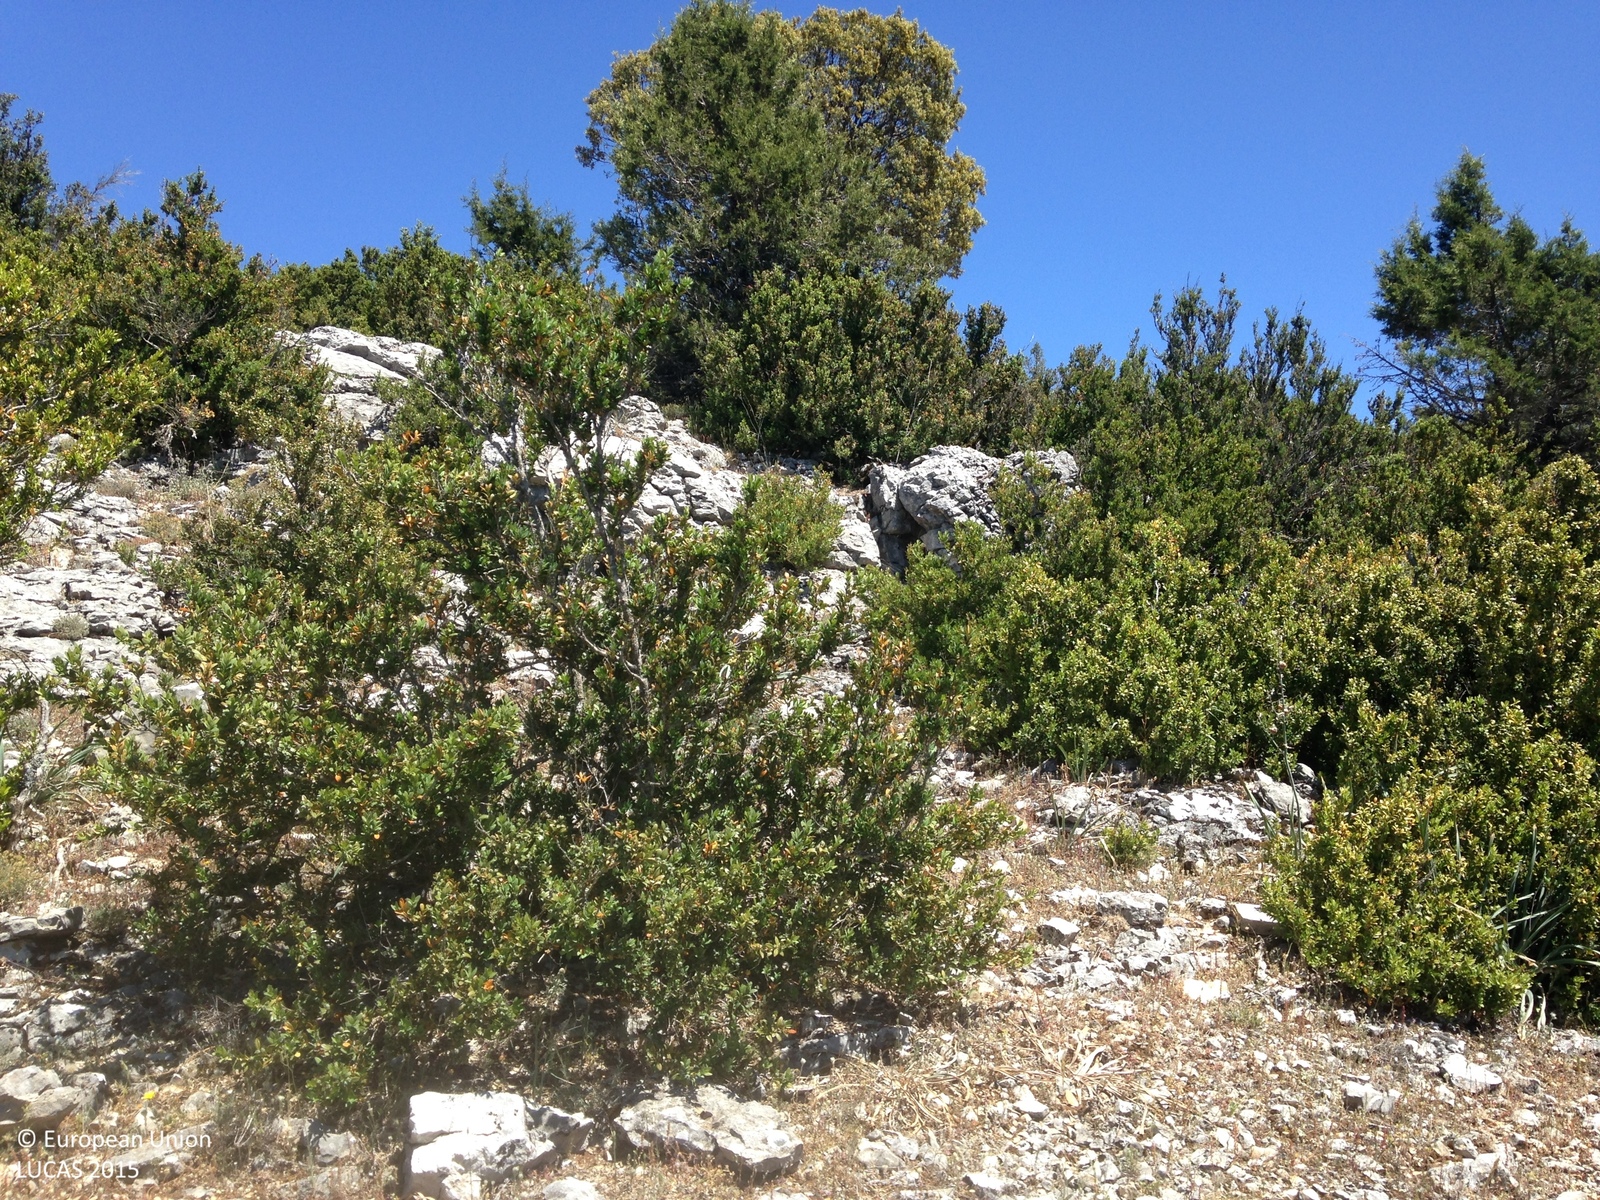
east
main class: Shrubland
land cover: Shrubland without tree cover
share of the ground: 10 - 25 %
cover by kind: shrubs 45 %, consolidated bare surface 35 %, herbaceous plants 20 %
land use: Semi-natural and natural areas not in use
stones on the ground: > 50 %
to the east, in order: Shrubland without tree cover; Rock outcrops; Shrubland with sparse tree cover; Shrubland without tree cover; Rock outcrops; Shrubland without tree cover; Shrubland with sparse tree cover; Tracks; Shrubland with sparse tree cover; Spontaneously vegetated surfaces
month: May
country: ES
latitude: 40.4909
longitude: -2.0421
